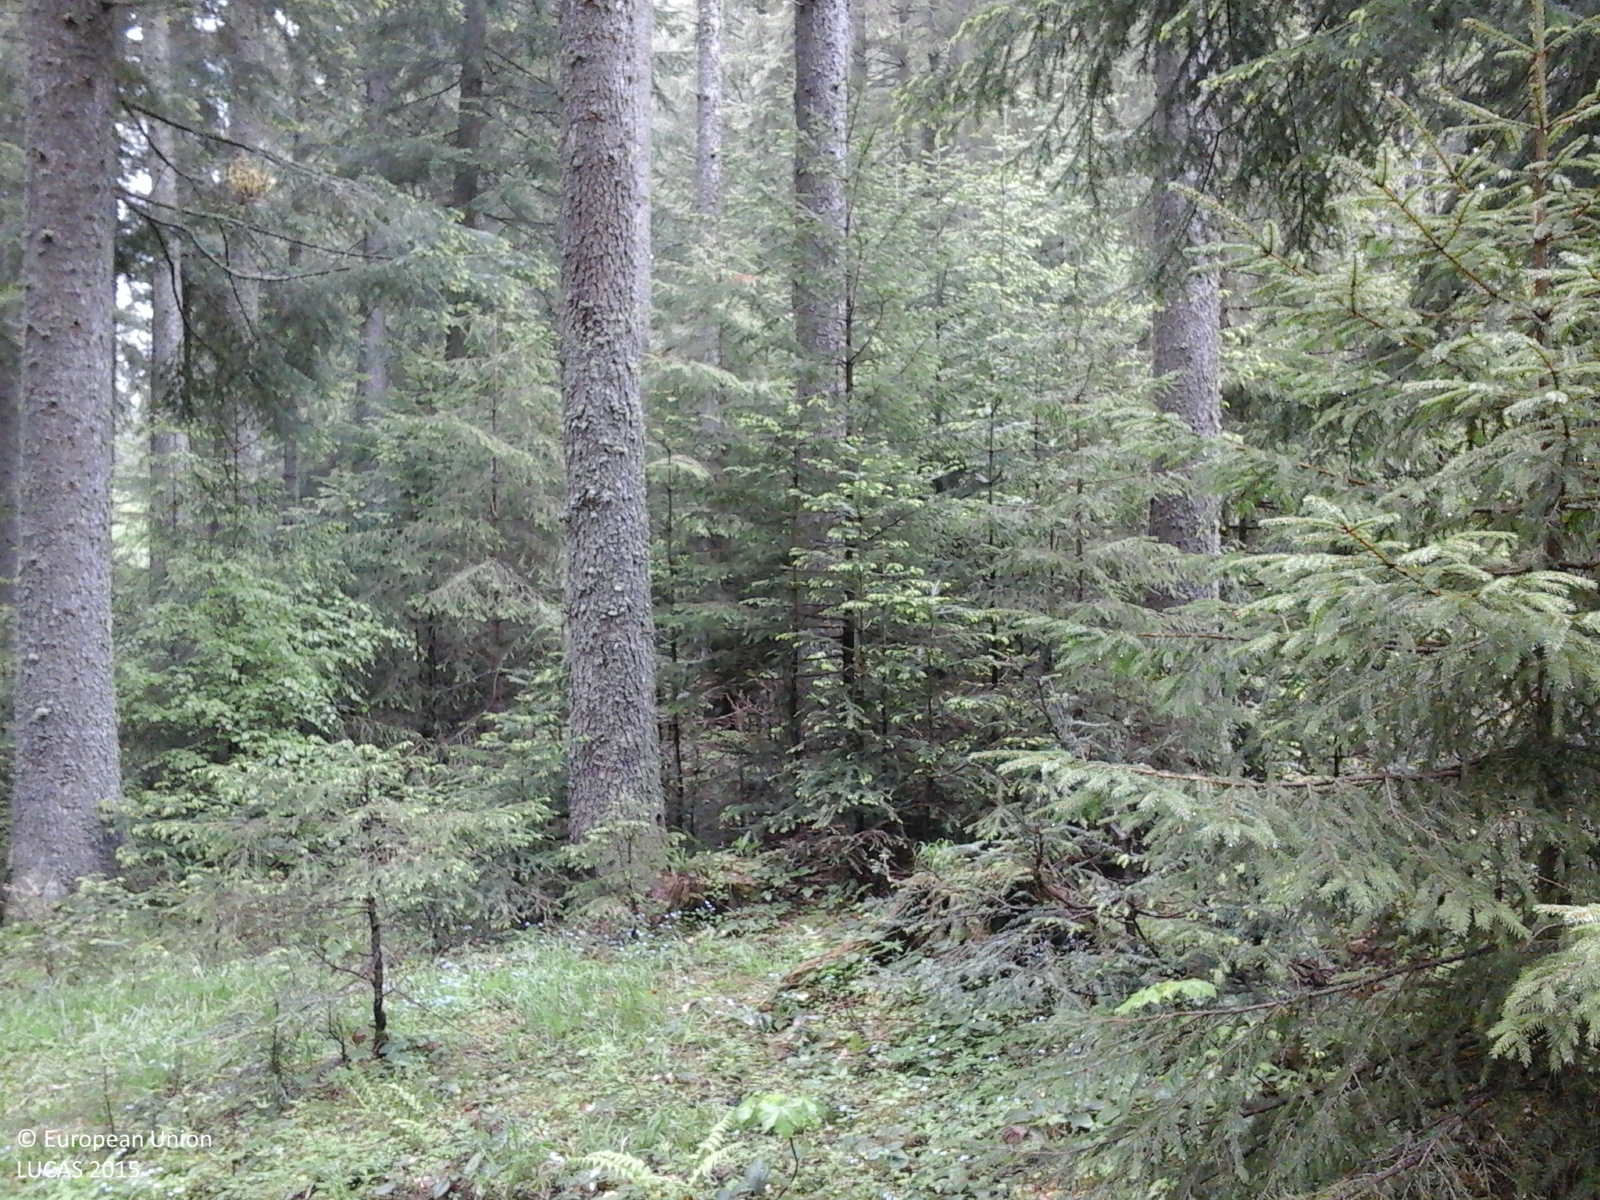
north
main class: Woodland
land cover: Spruce dominated coniferous woodland
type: alpine coniferous forest
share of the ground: > 75 %
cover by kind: coniferous forest trees 90 %, broadleaved forest trees 10 %
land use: Forestry
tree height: > 5 m
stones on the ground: < 10 %
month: May
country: RO
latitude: 45.4875
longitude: 25.6238
